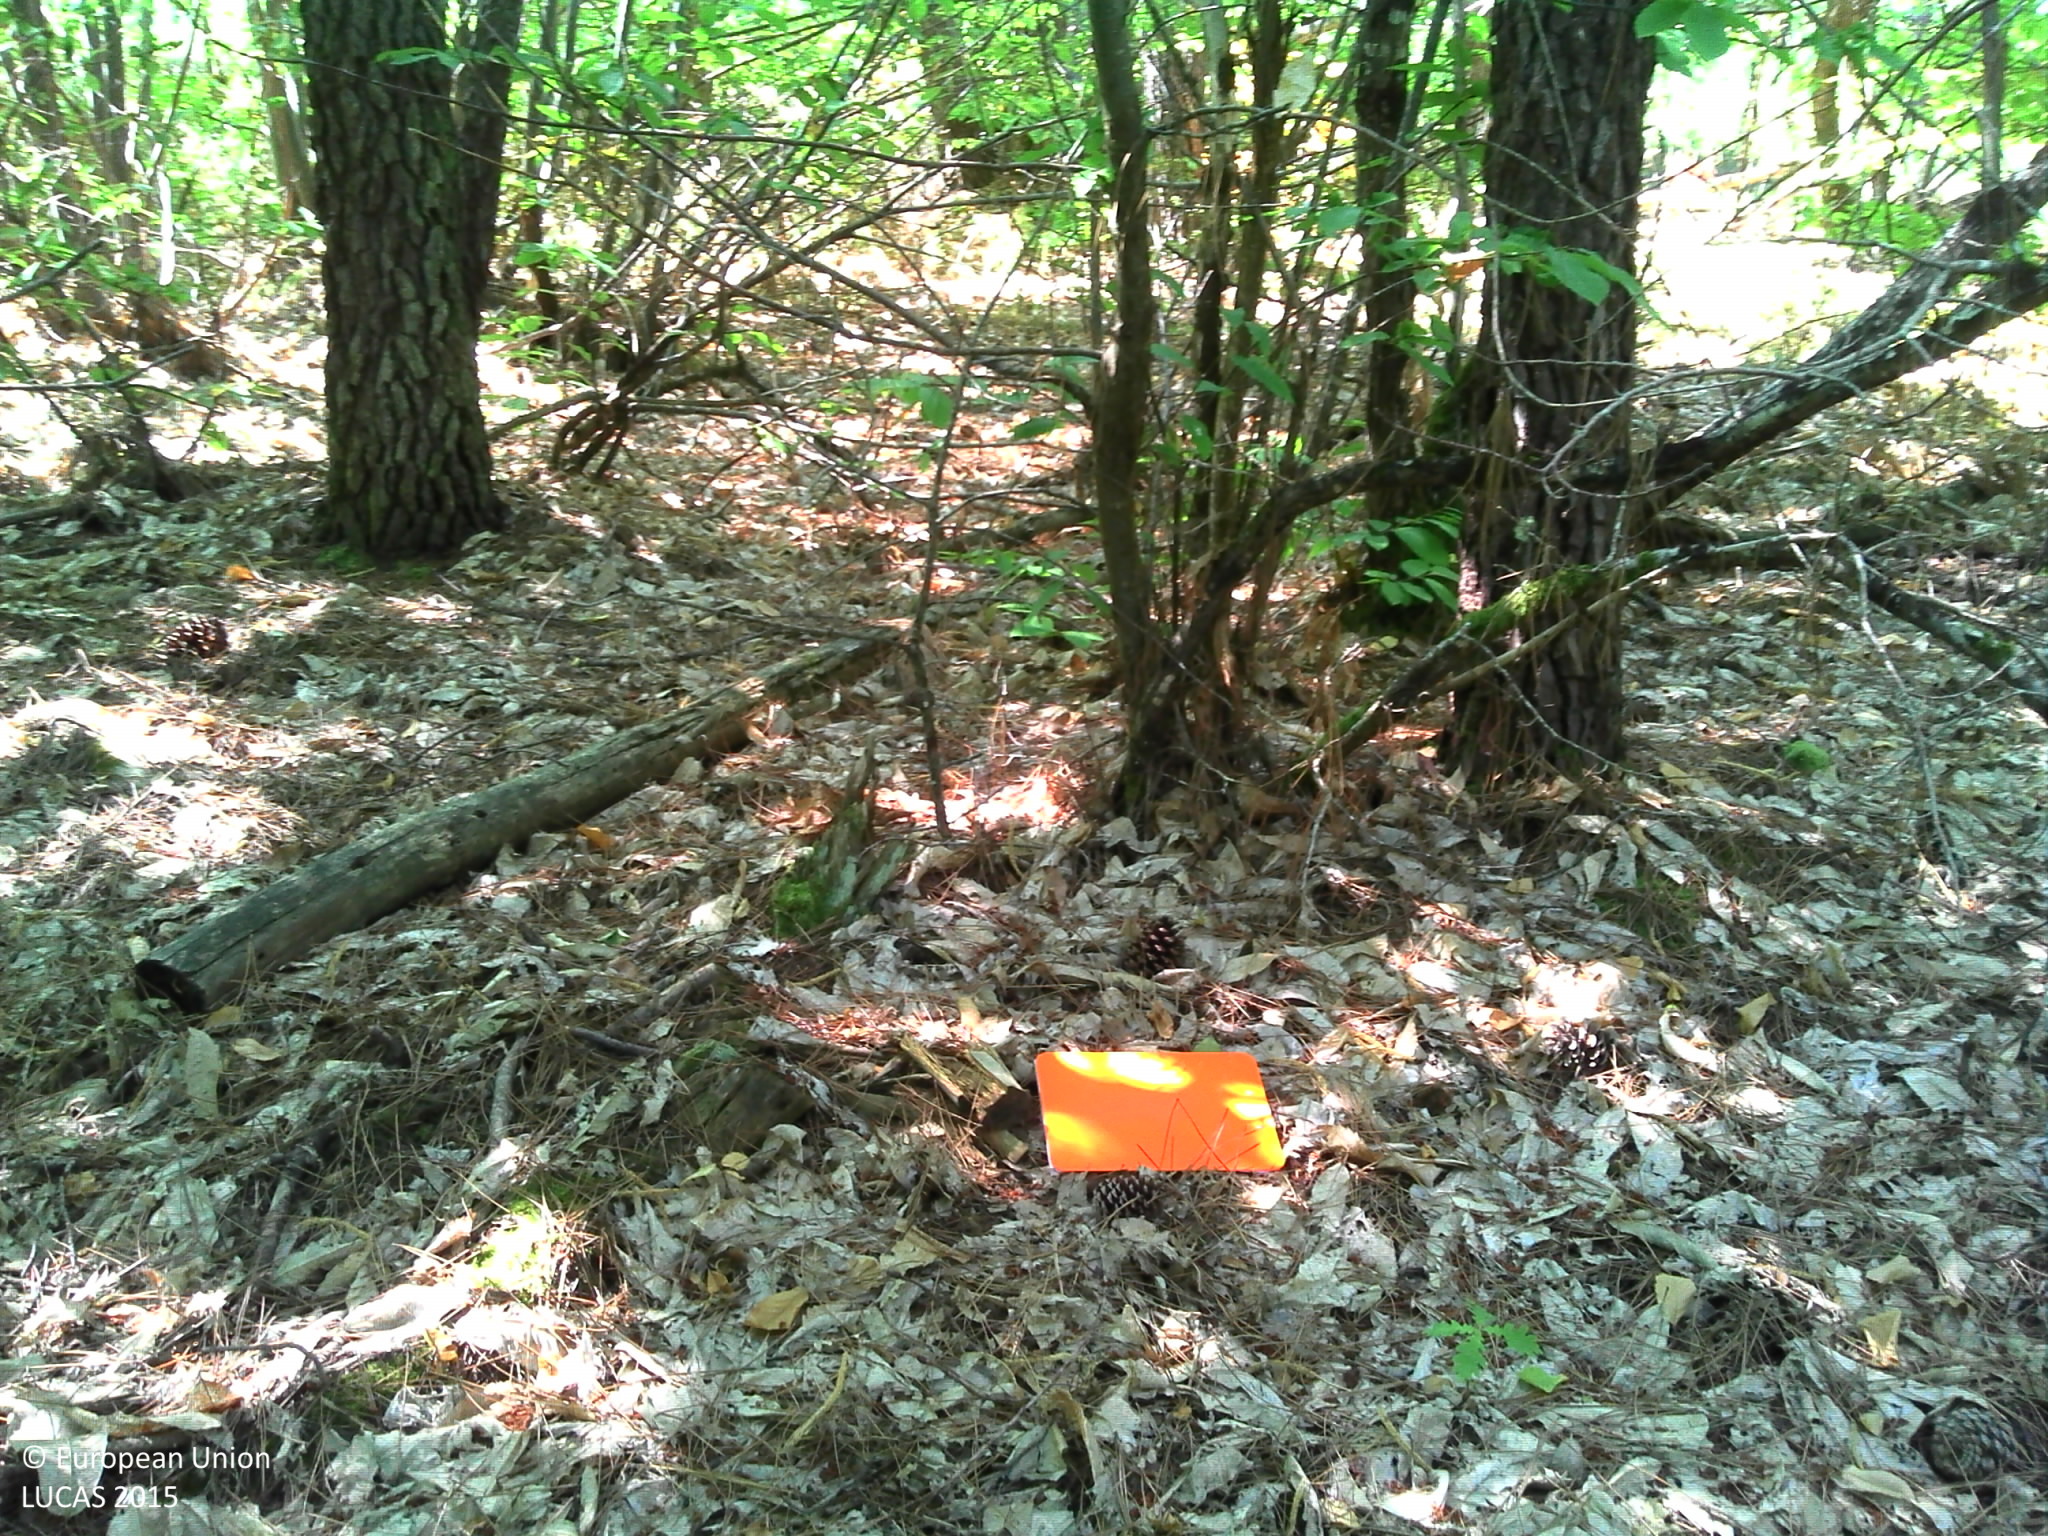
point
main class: Woodland
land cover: Broadleaved woodland
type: thermophilous deciduous forest
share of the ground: > 75 %
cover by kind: broadleaved forest trees 40 %, unconsolidated bare surface 20 %, coniferous forest trees 10 %, shrubs 10 %, herbaceous plants 10 %, lichens and mosses 10 %
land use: Forestry
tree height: > 5 m
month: July
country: FR
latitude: 45.0729
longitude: 0.4752
